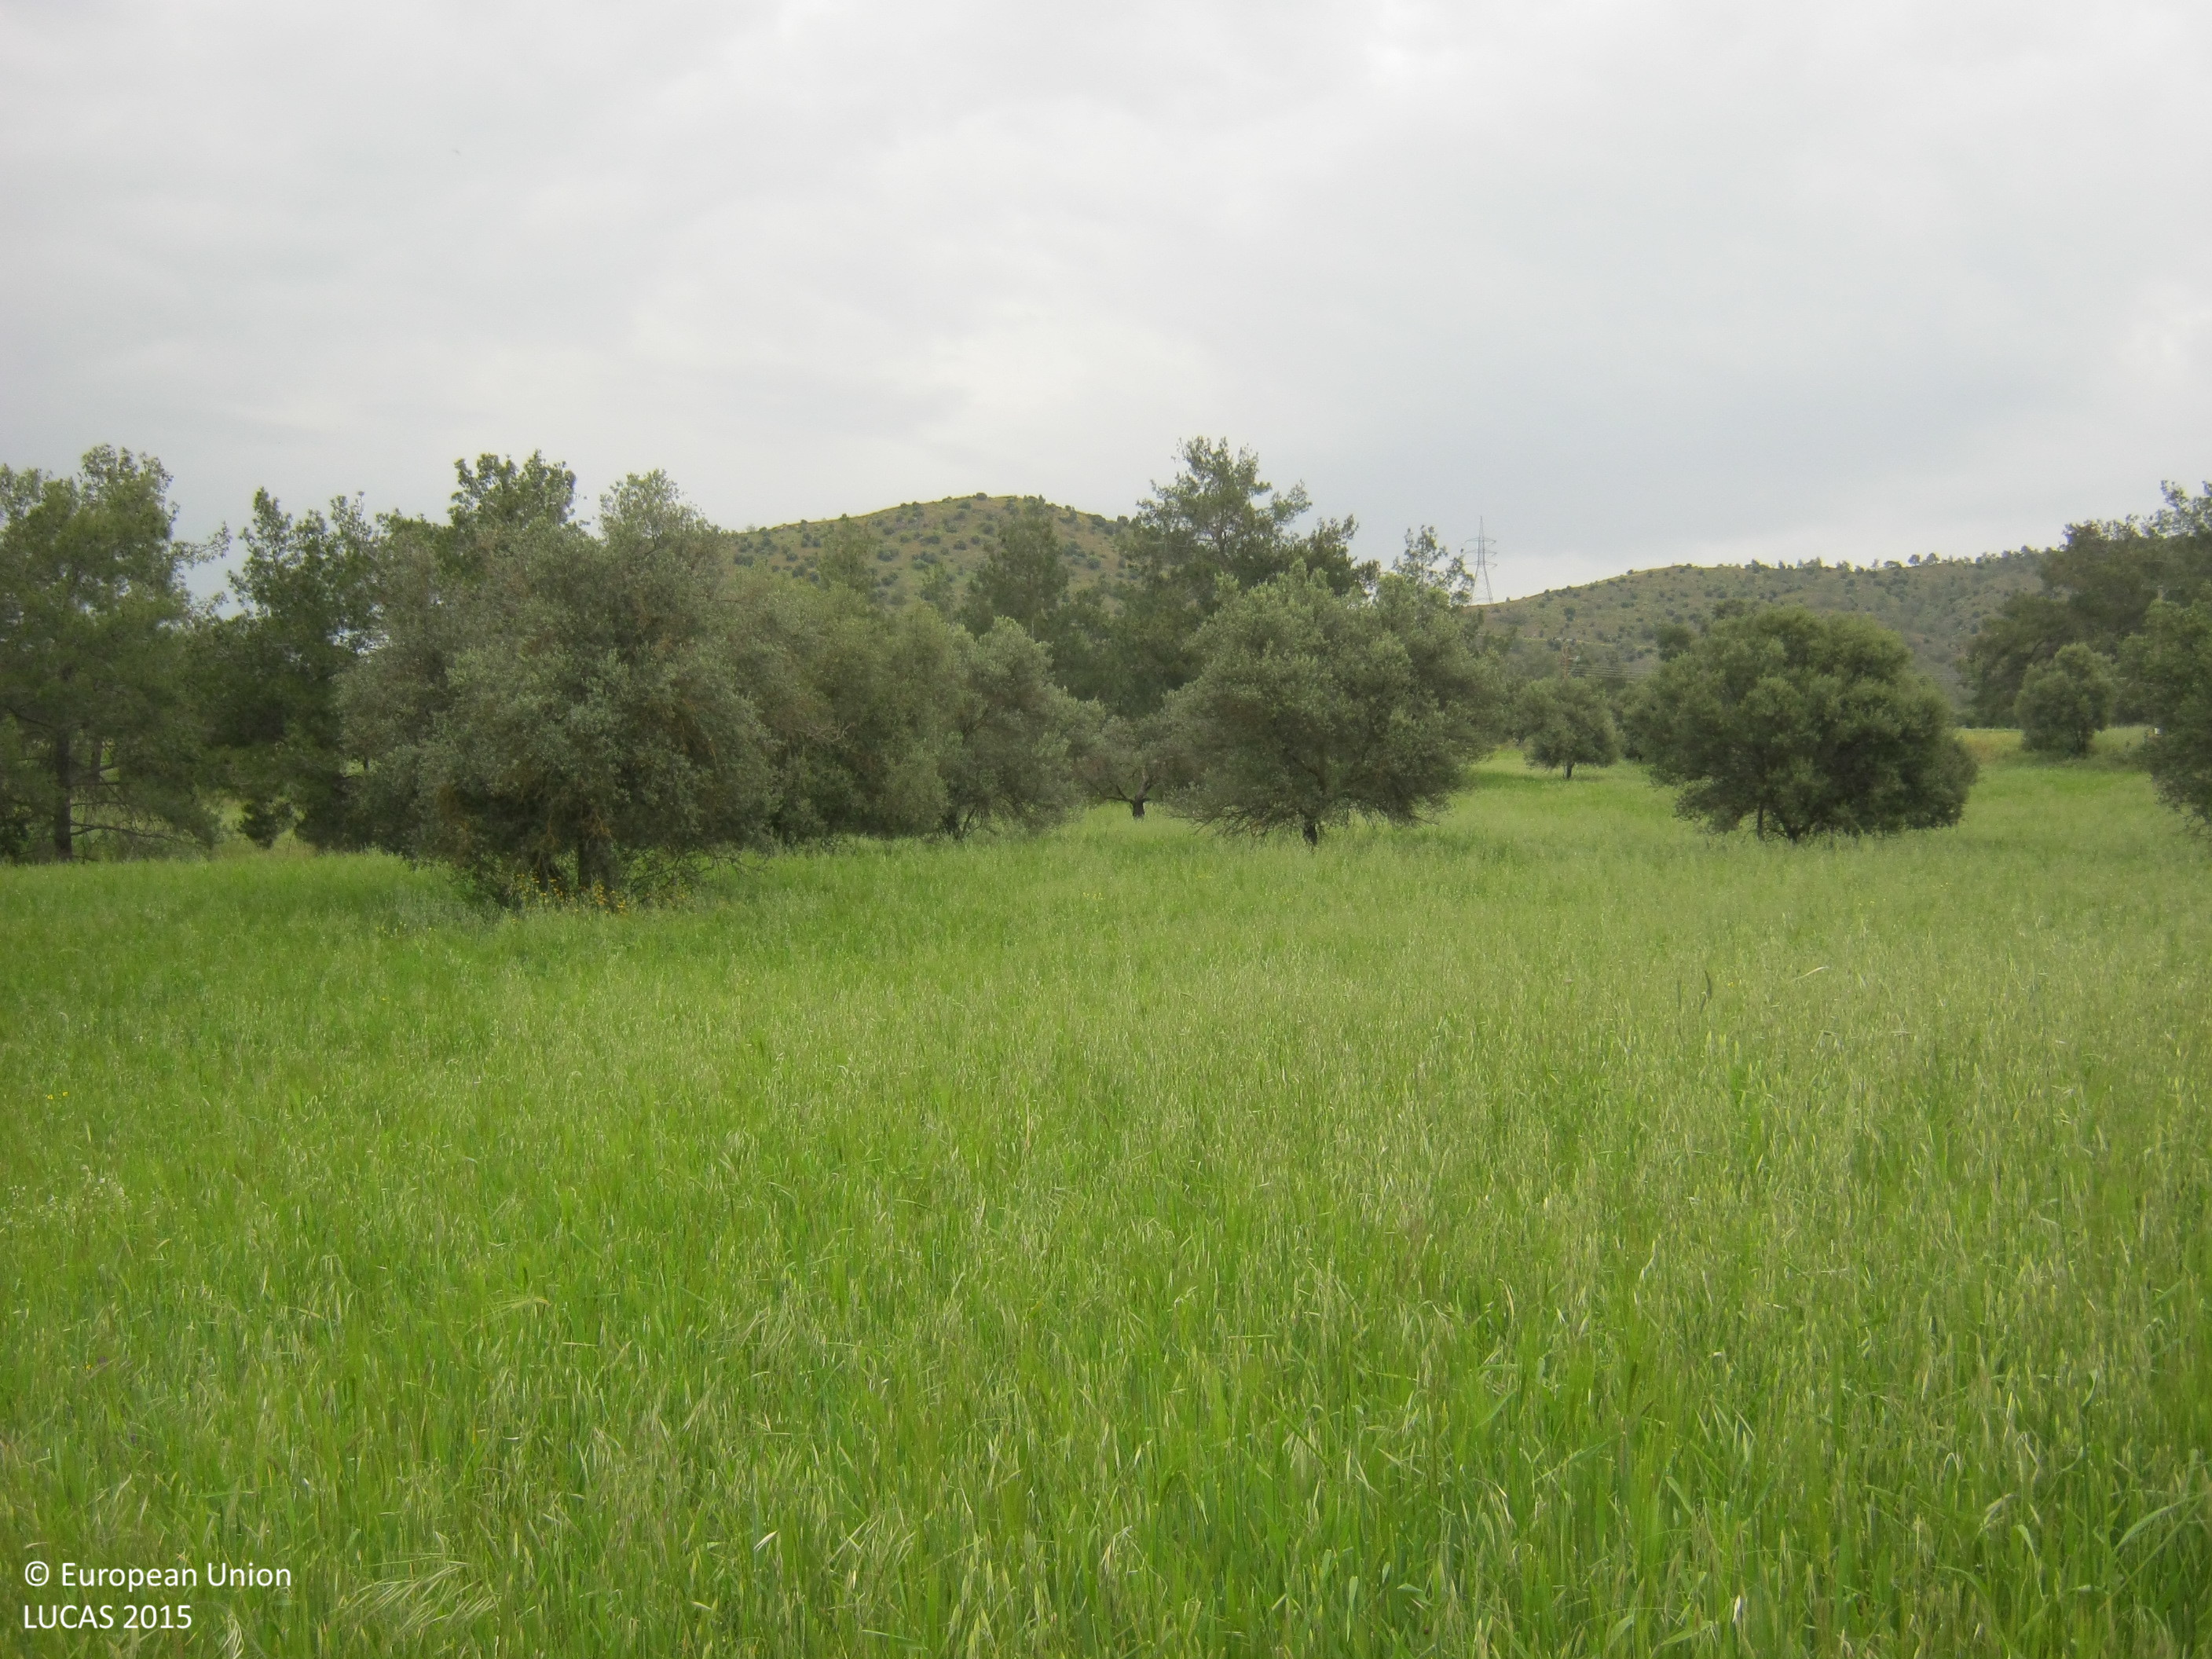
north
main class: Cropland
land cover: Common wheat
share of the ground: > 75 %
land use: Agriculture (excluding fallow land and kitchen gardens)
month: April
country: CY
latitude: 34.9263
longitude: 33.3604
